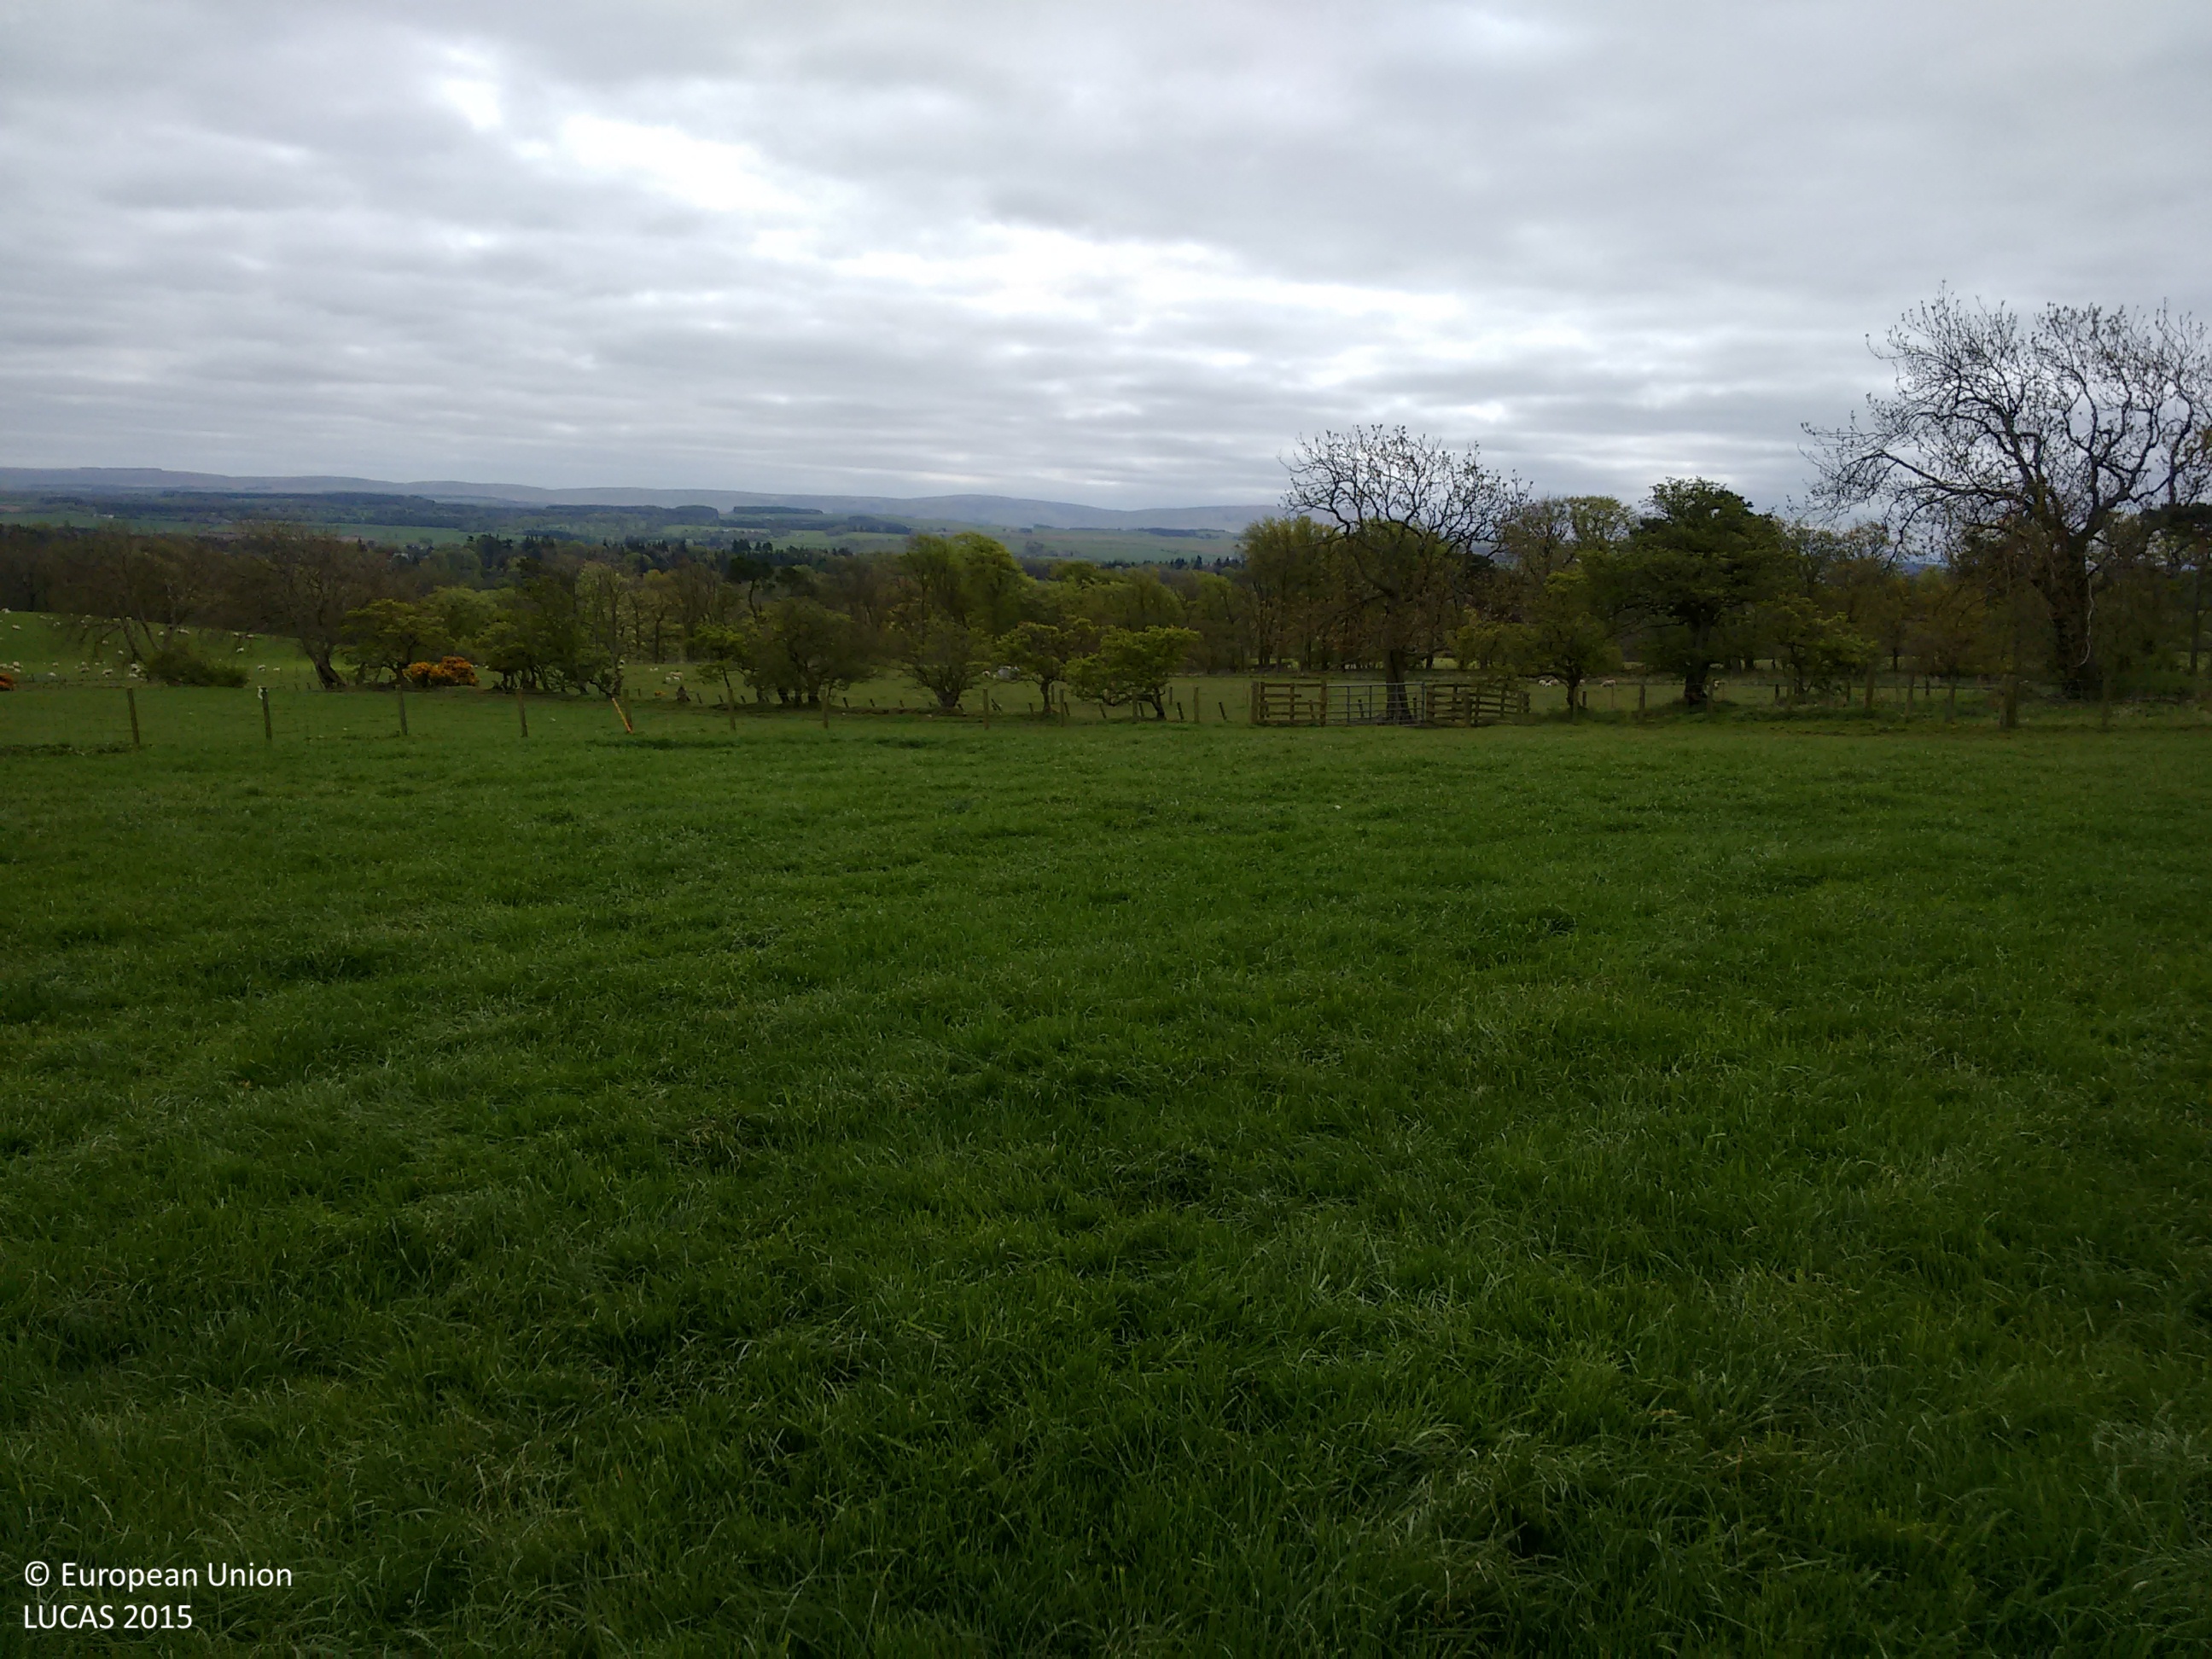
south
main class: Grassland
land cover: Grassland without tree/shrub cover
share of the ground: > 75 %
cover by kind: herbaceous plants 100 %
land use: Agriculture (excluding fallow land and kitchen gardens)
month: May
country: GB
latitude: 55.8644
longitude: -3.2230
